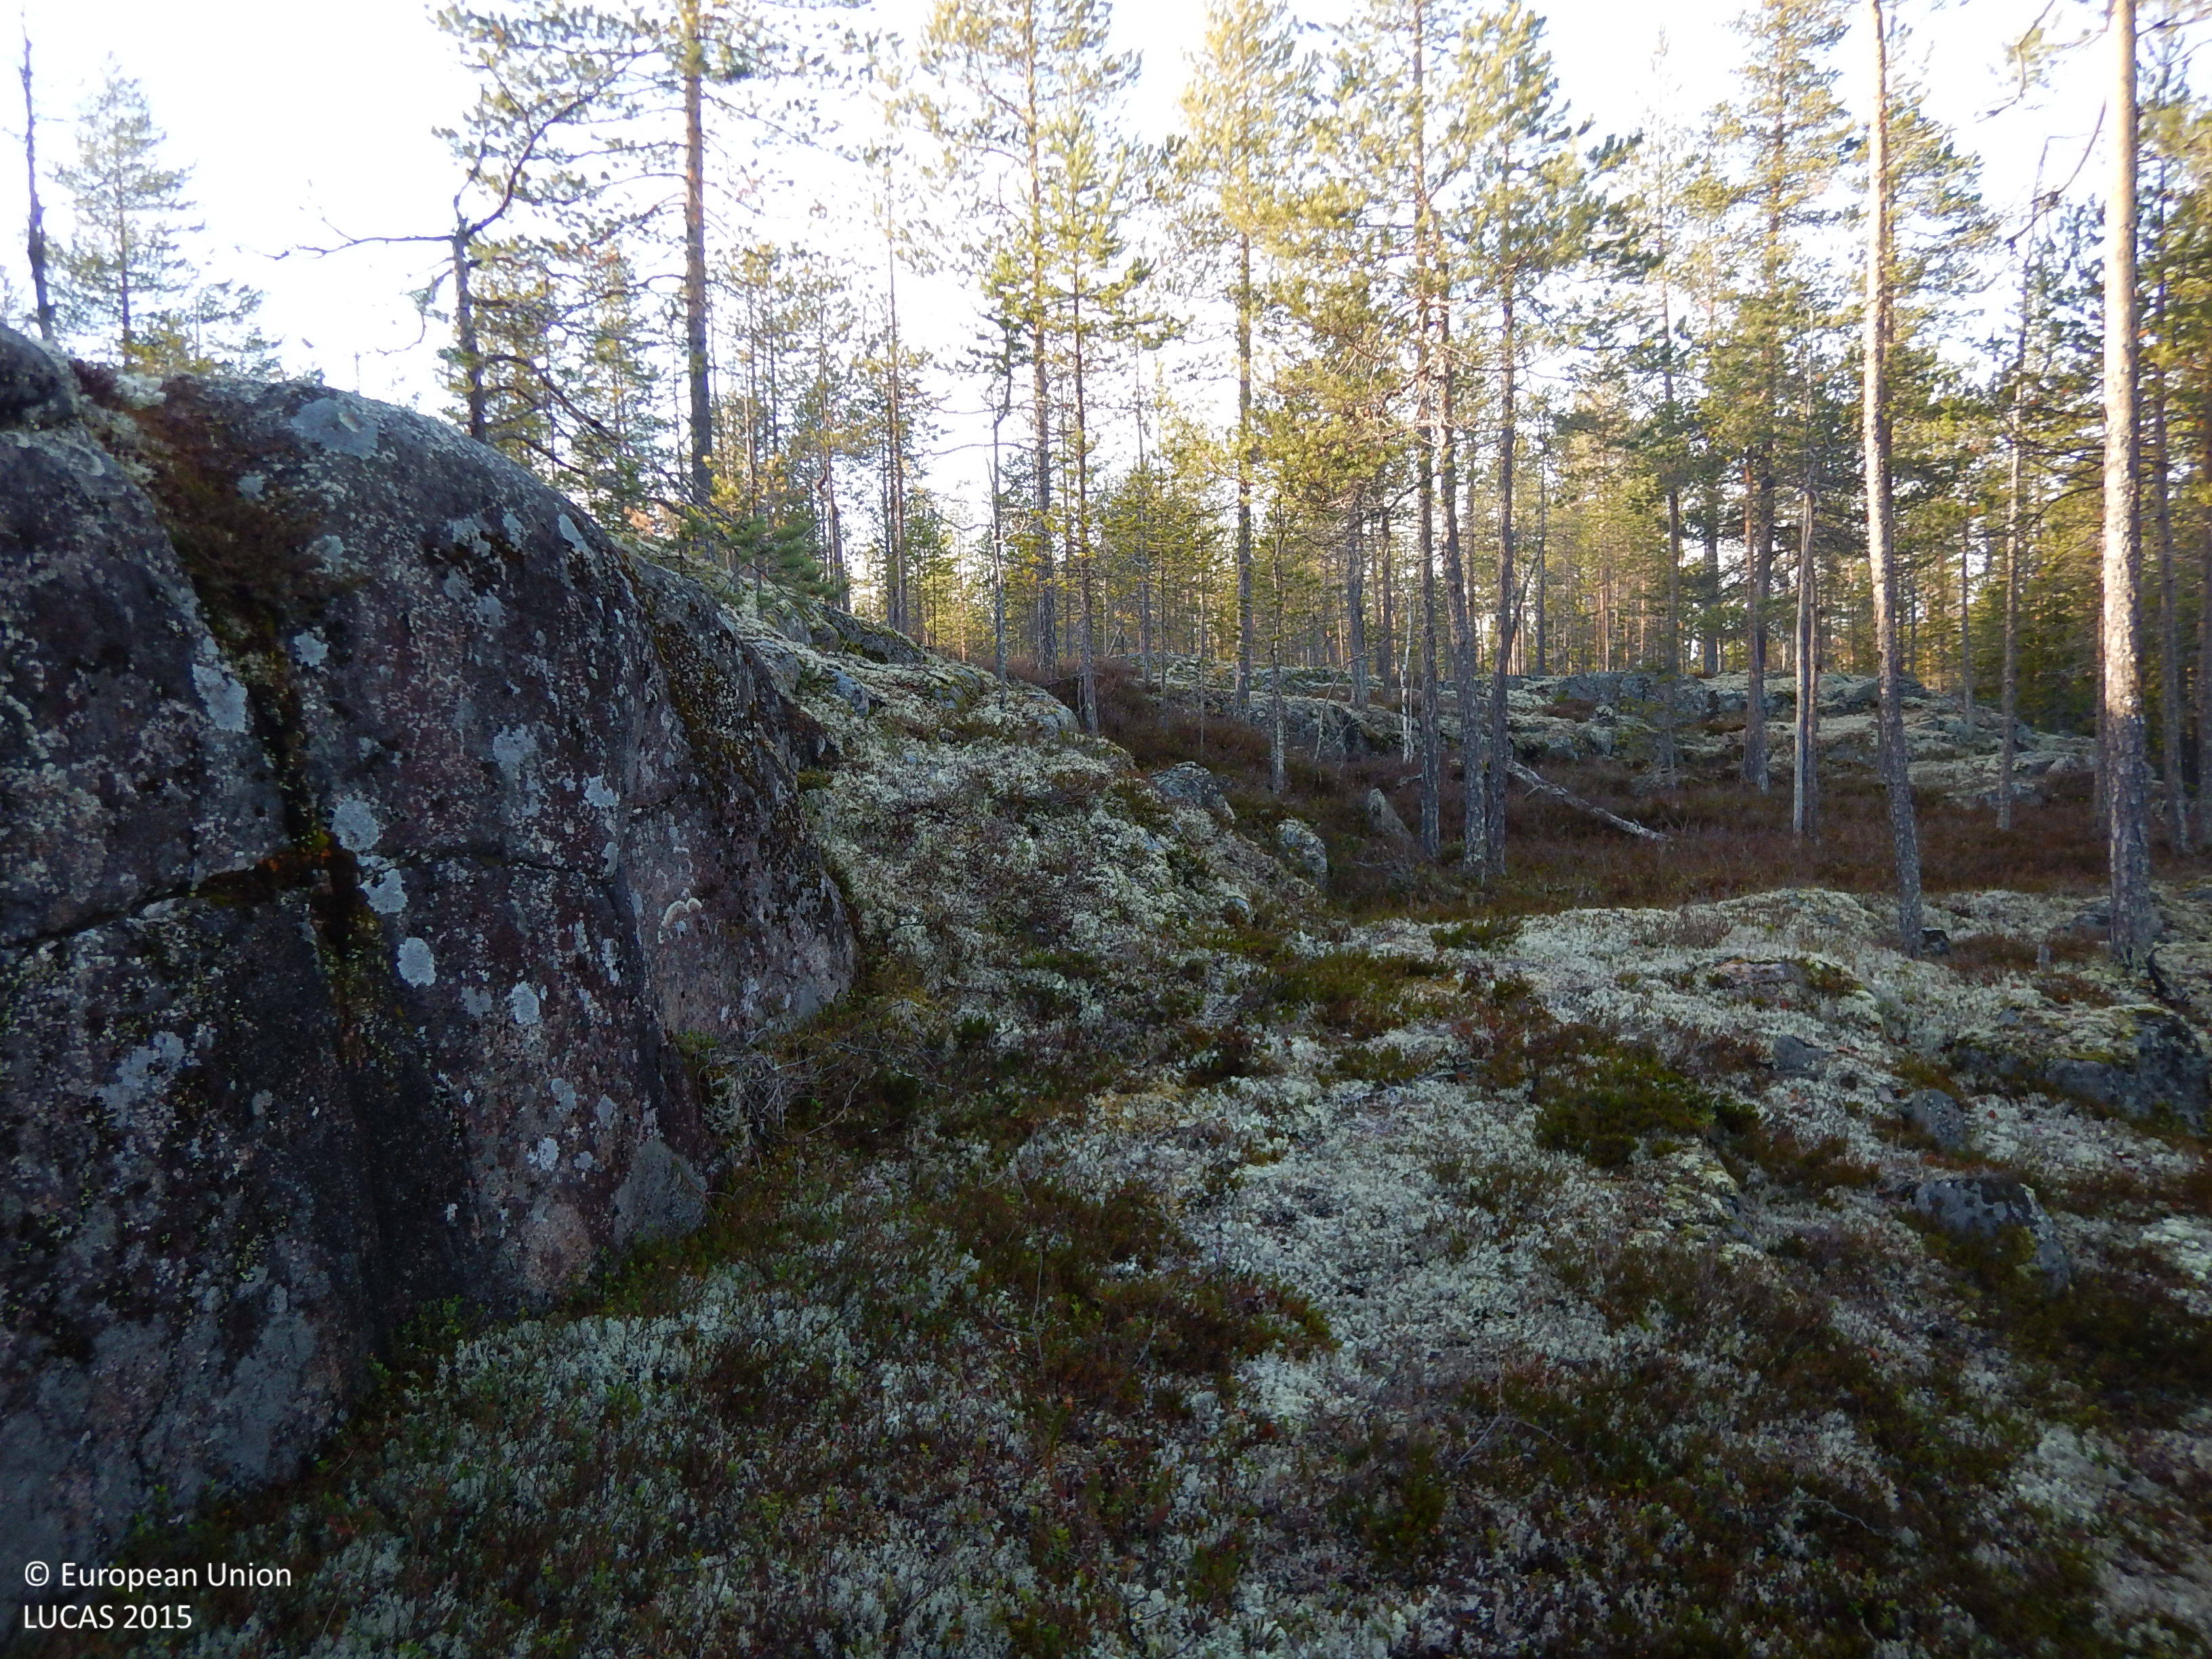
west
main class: Woodland
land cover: Pine dominated coniferous woodland
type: boreal forest
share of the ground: 50 - 75 %
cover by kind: coniferous forest trees 55 %, shrubs 15 %, herbaceous plants 10 %, lichens and mosses 10 %, consolidated bare surface 10 %
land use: Forestry
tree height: > 5 m
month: October
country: SE
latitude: 65.2713
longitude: 20.2300
